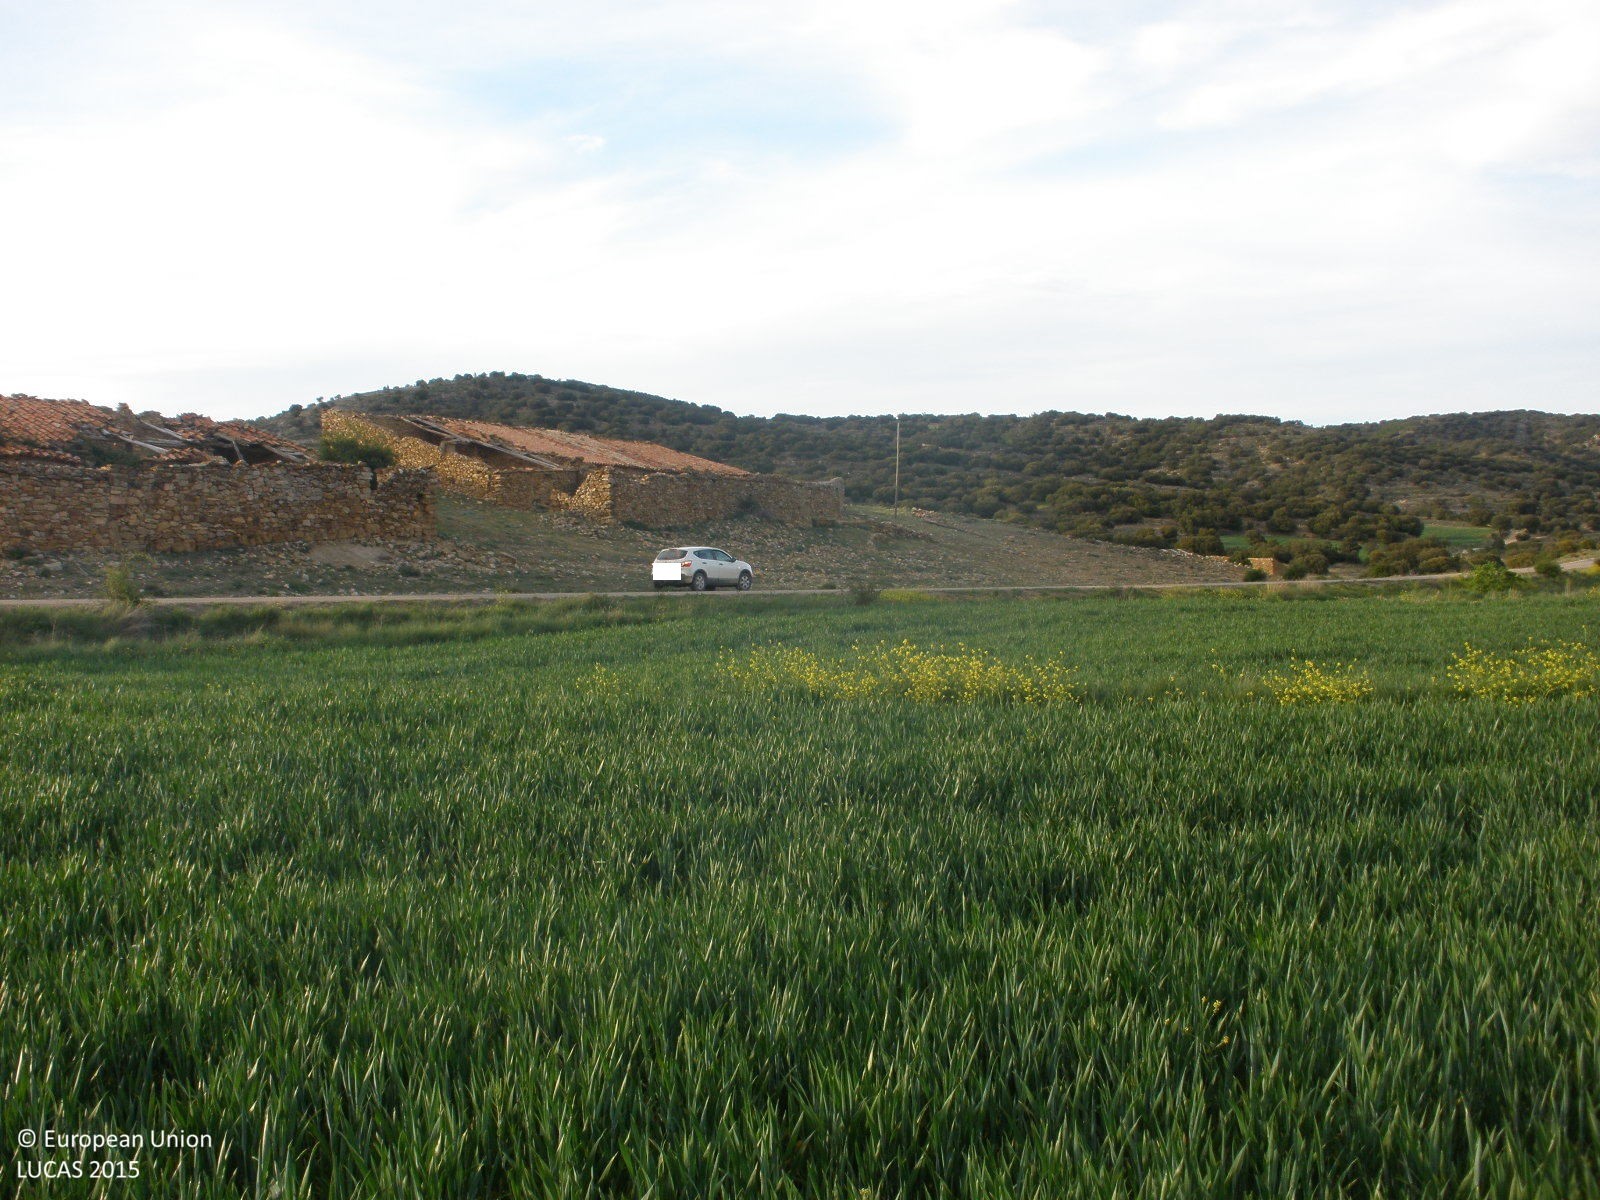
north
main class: Cropland
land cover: Durum wheat
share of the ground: > 75 %
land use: Agriculture (excluding fallow land and kitchen gardens)
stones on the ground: < 10 %
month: May
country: ES
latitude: 40.8061
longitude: -0.9076
